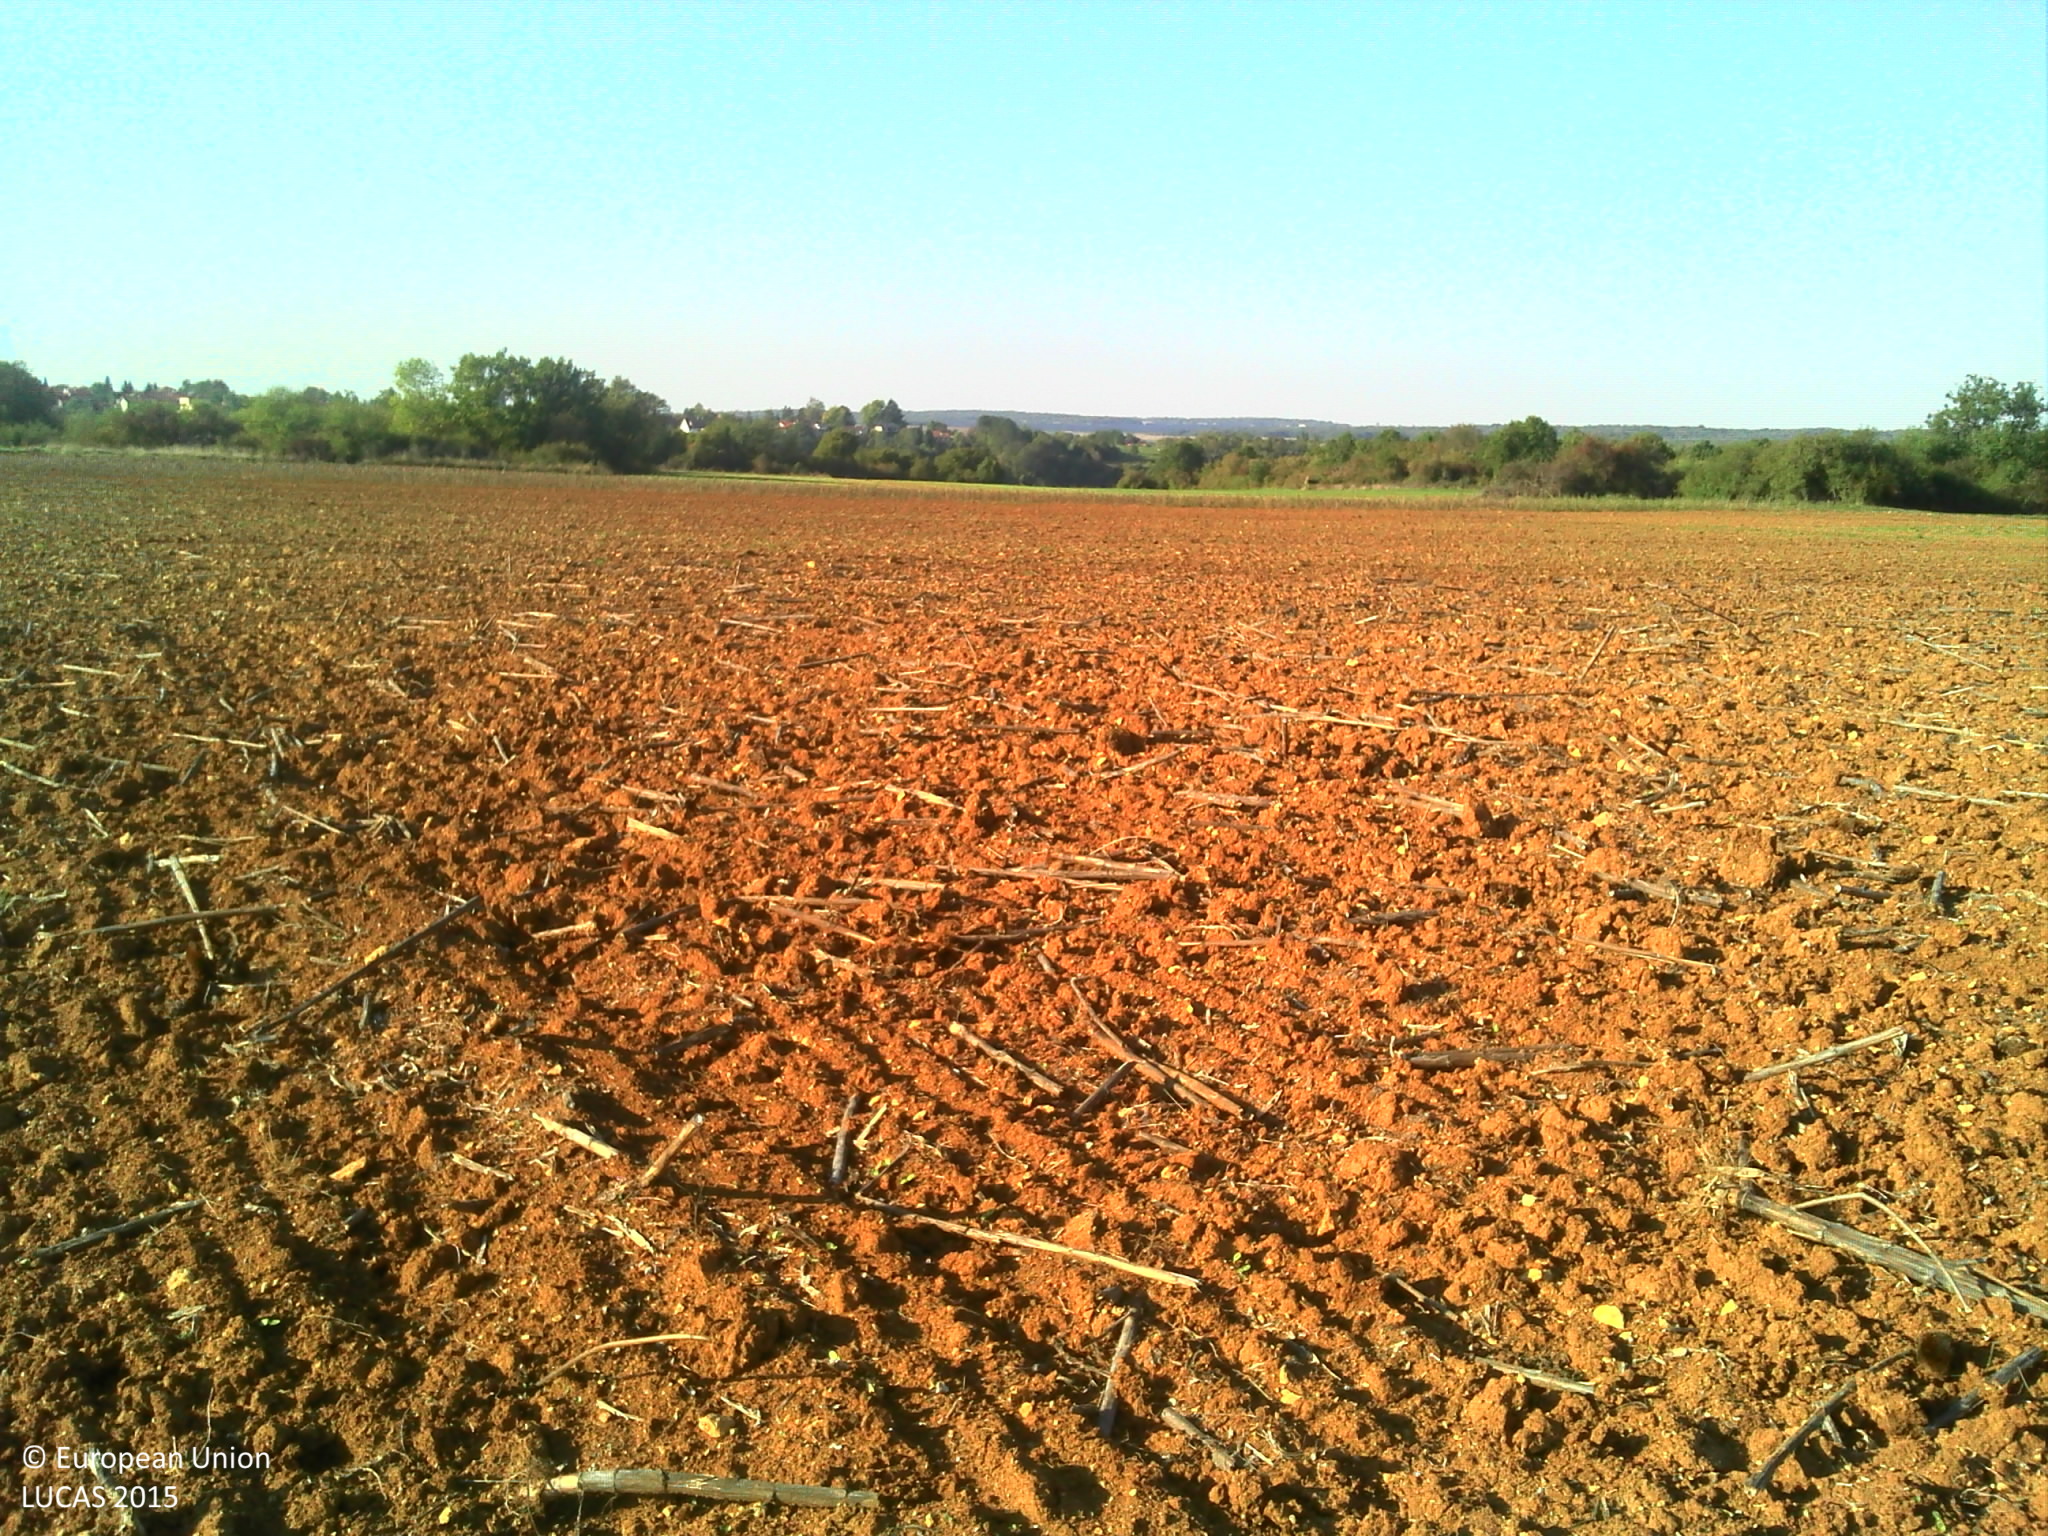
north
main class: Cropland
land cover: Sunflower
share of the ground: < 10 %
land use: Agriculture (excluding fallow land and kitchen gardens)
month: October
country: FR
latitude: 48.7271
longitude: 5.9894
